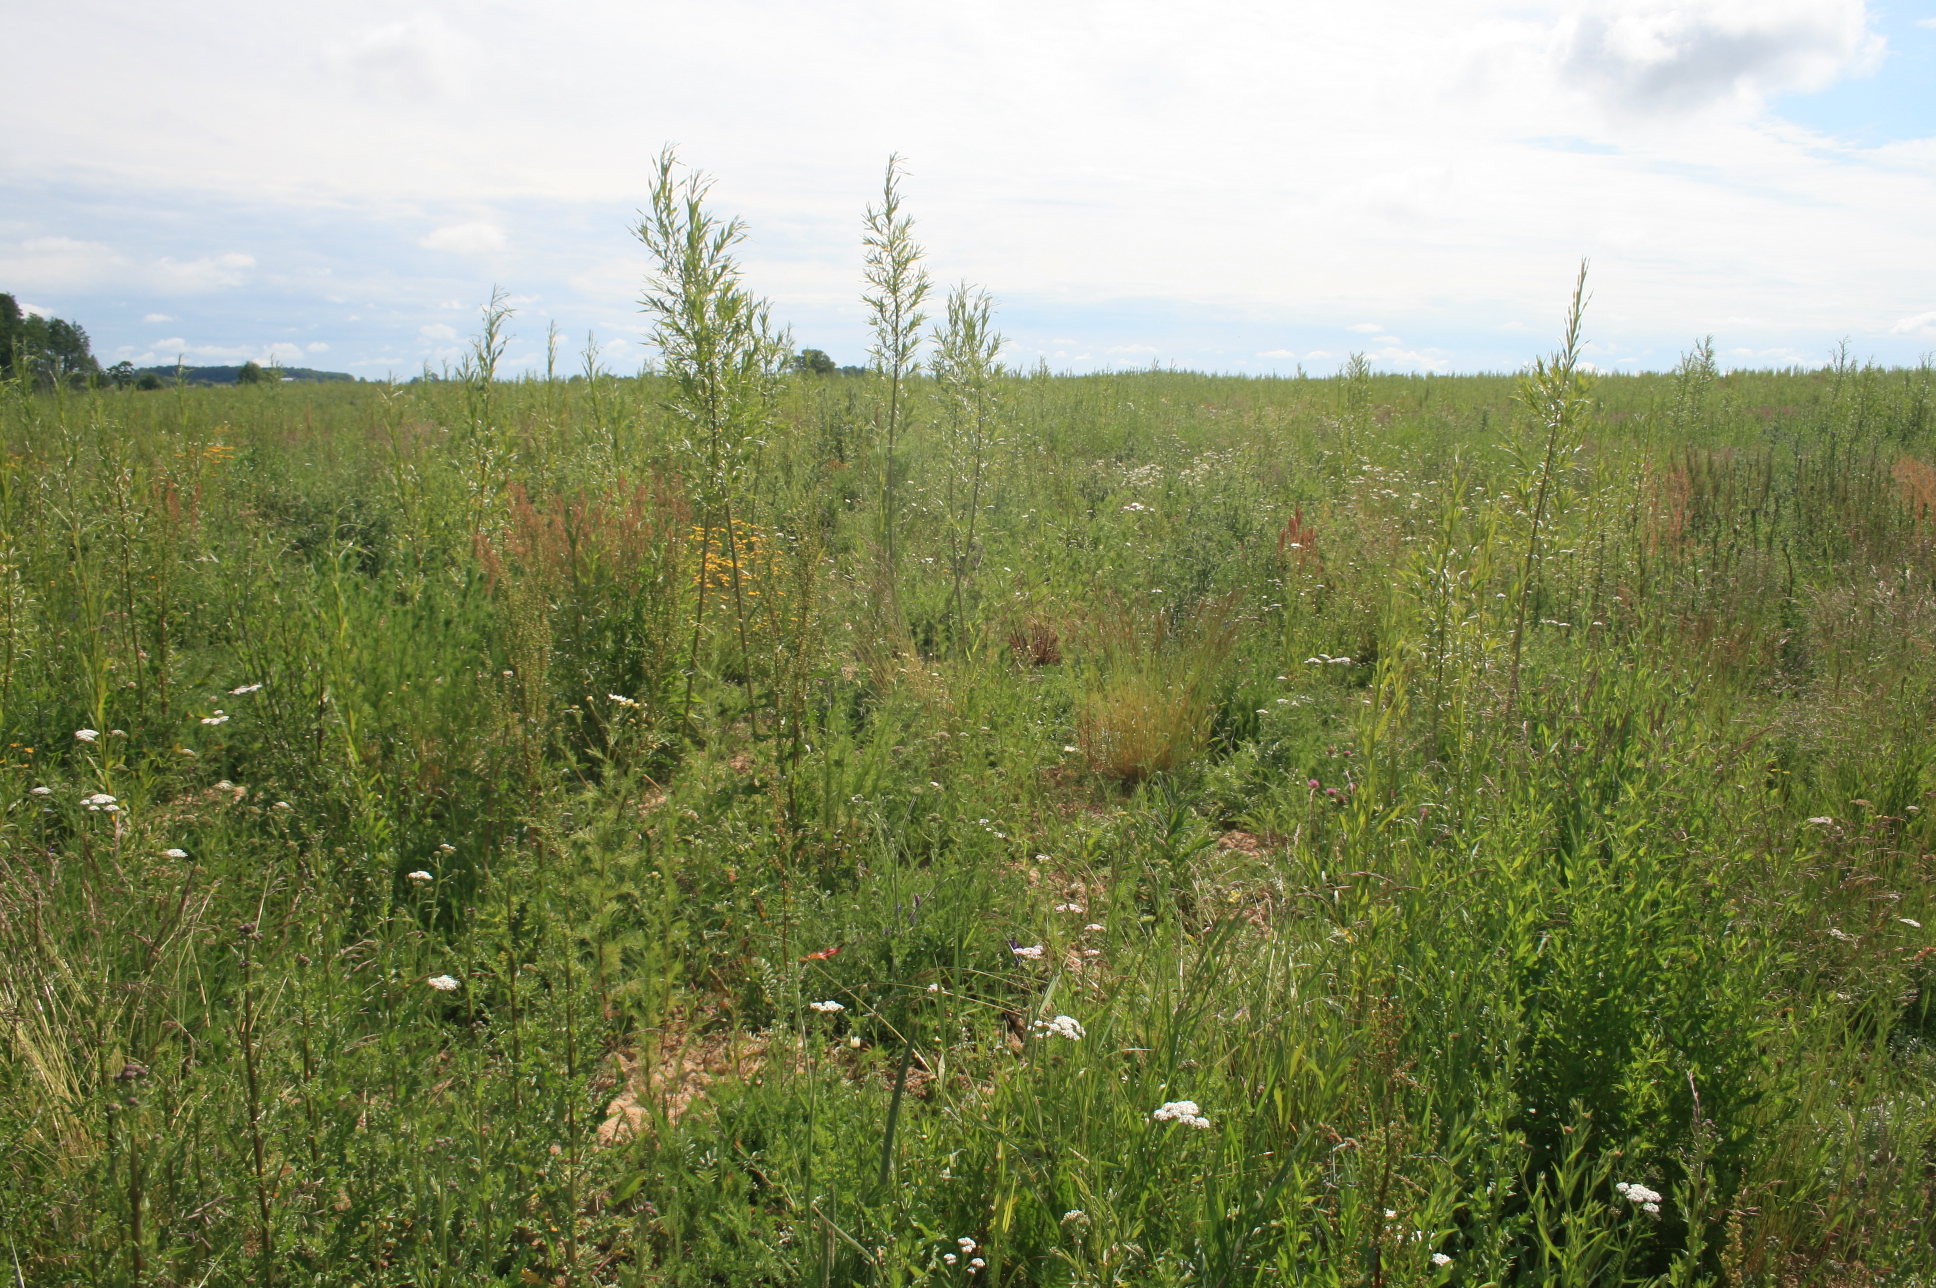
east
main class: Shrubland
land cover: Shrubland without tree cover
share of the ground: 50 - 75 %
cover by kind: shrubs 60 %, herbaceous plants 40 %
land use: Abandoned areas
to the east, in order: Shrubland without tree cover
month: June
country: LT
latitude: 55.2496
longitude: 22.0894
